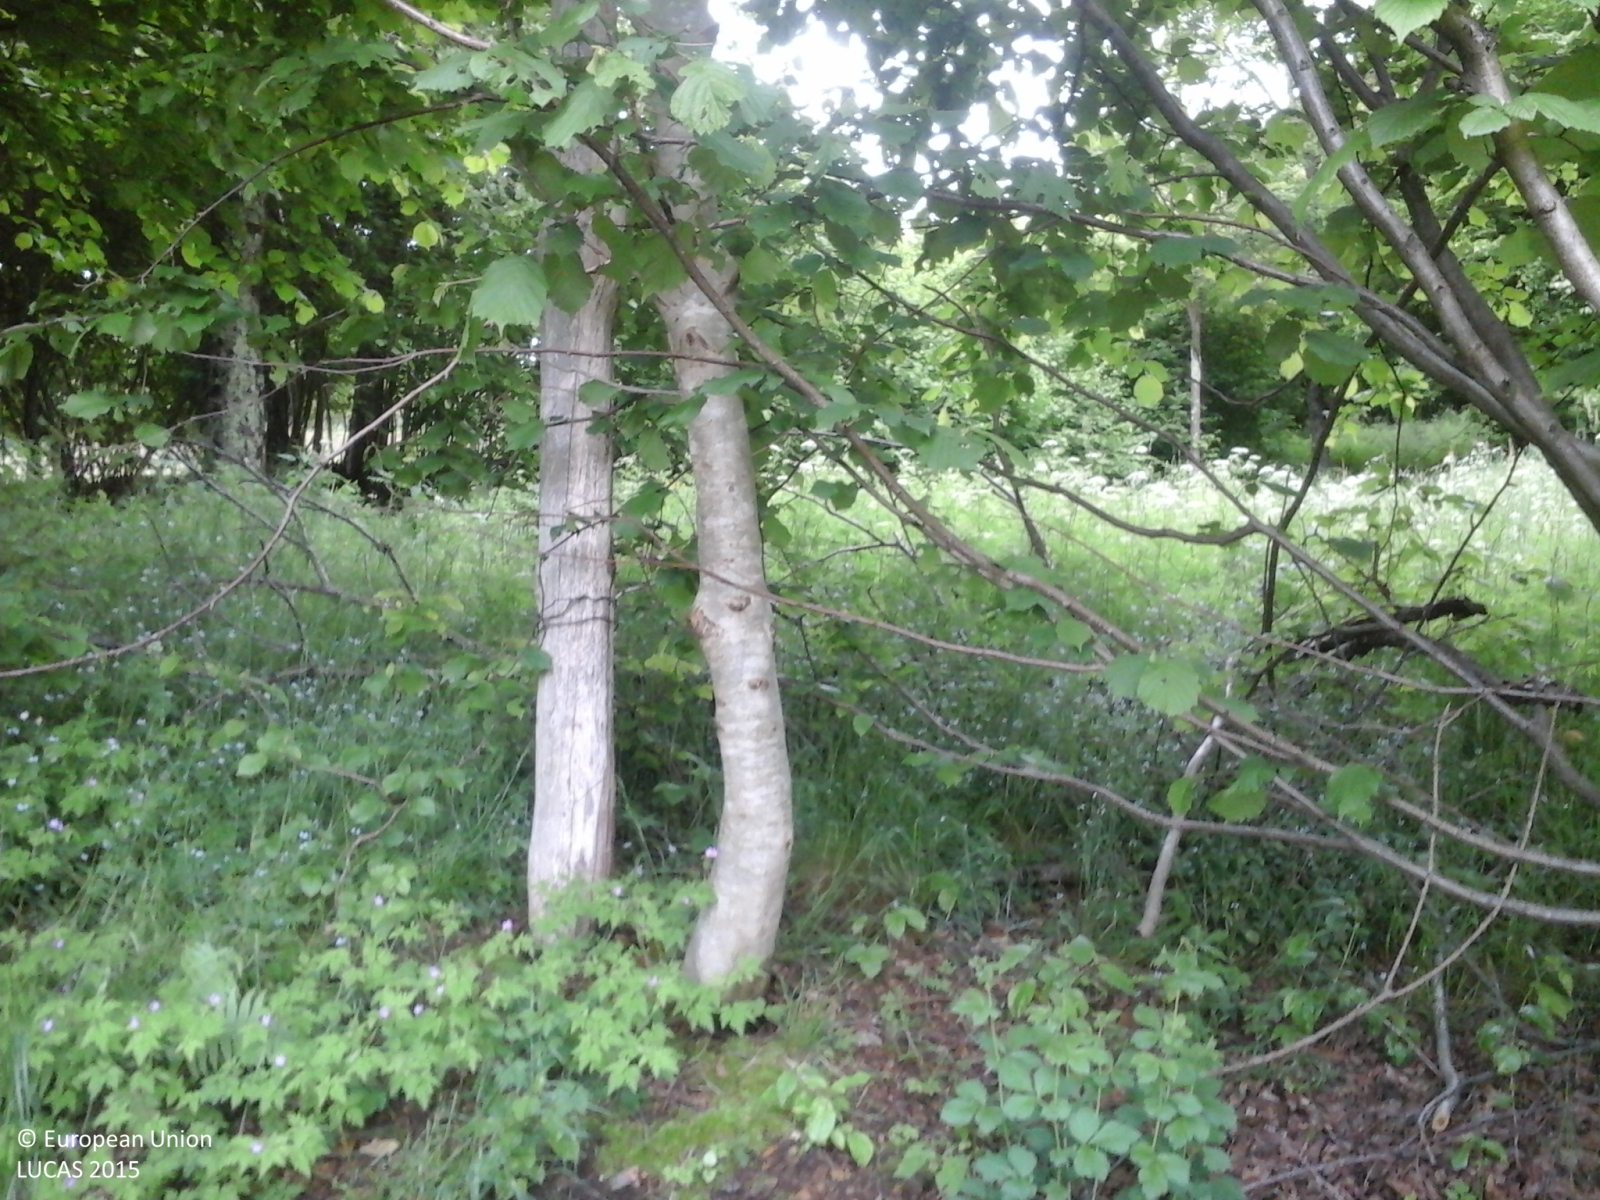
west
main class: Woodland
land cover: Broadleaved woodland
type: thermophilous deciduous forest
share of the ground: > 75 %
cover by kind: broadleaved forest trees 90 %, herbaceous plants 10 %
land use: Forestry
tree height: > 5 m
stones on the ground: < 10 %
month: May
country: IT
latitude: 45.7854
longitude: 11.2458
